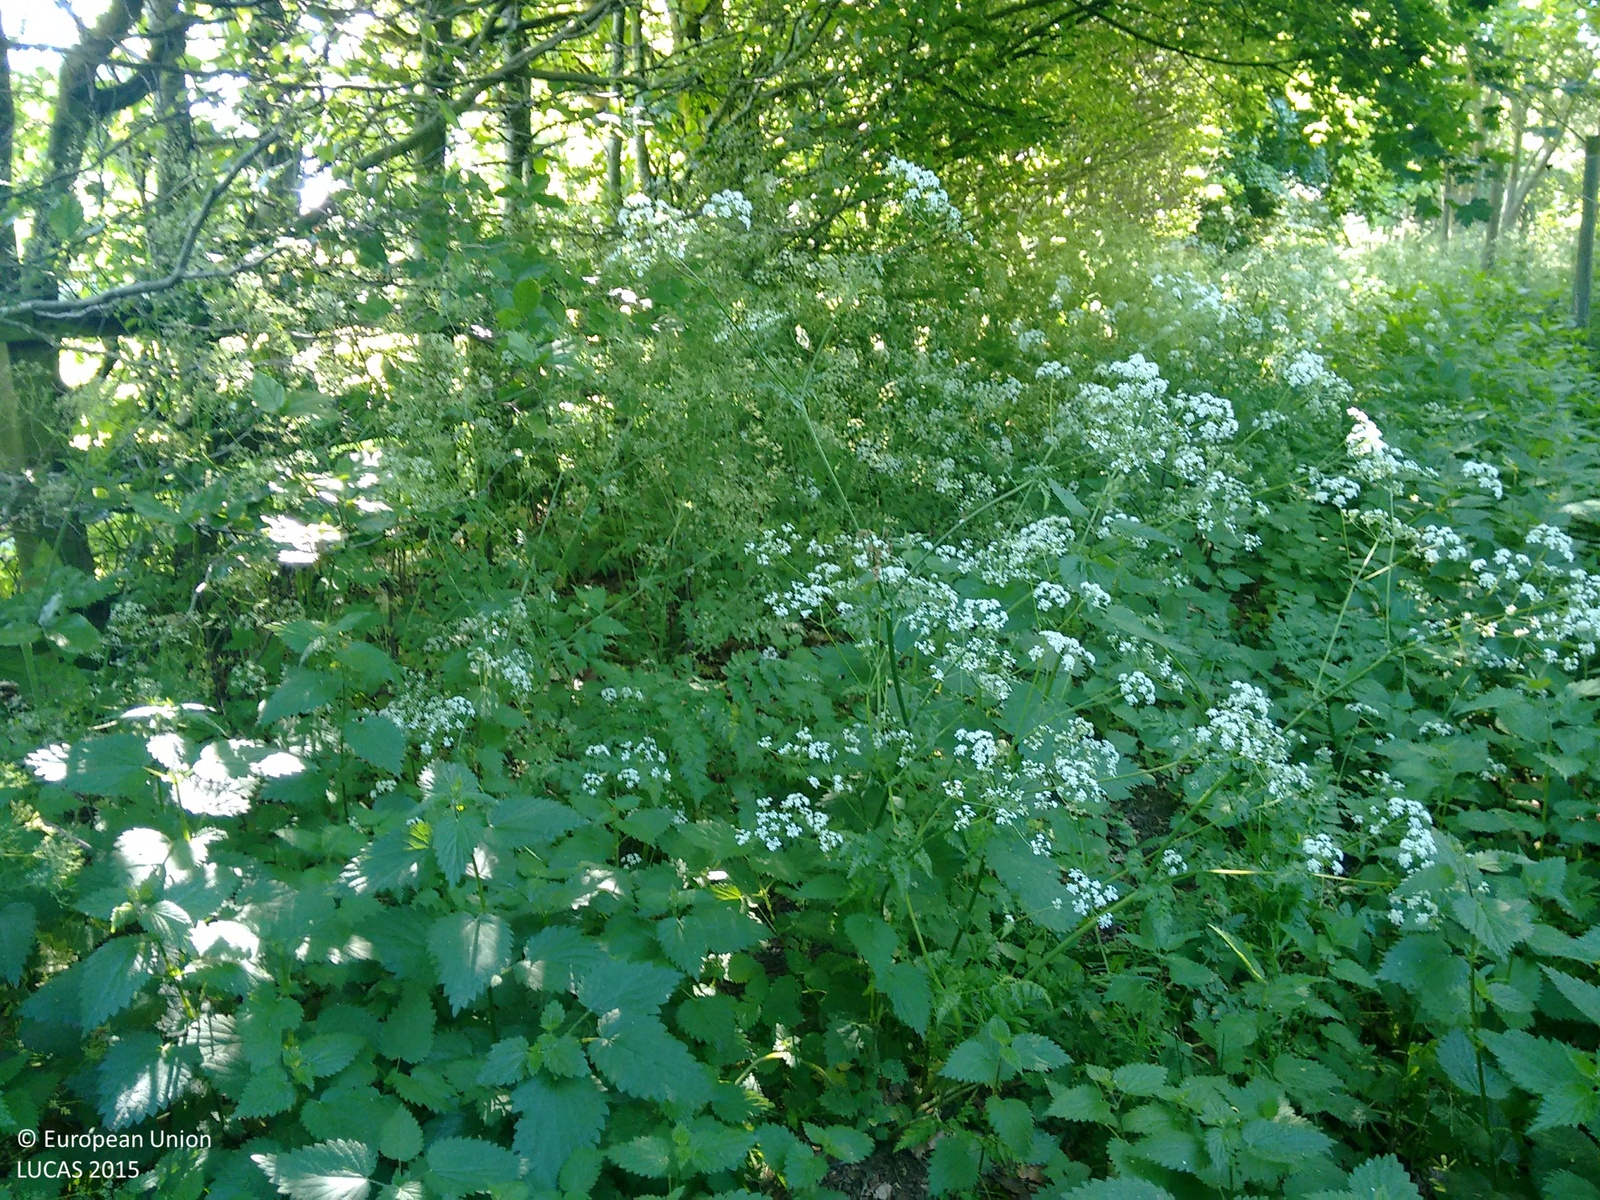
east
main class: Woodland
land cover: Broadleaved woodland
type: mesophytic deciduous forest
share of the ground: > 75 %
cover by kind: broadleaved forest trees 95 %, shrubs 5 %
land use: Forestry
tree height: > 5 m
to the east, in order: Broadleaved woodland; Fences; Spontaneously vegetated surfaces; Fences; Lines of trees; Grassland without tree/shrub cover; Fences; Grassland without tree/shrub cover; Fences; Grass margins; Managed hedges; Fences; Ditches and canals; Grass margins; Paved roads, cycling and walking lanes; Grass margins; Ditches and canals; Lines of trees; Grassland without tree/shrub cover; Common wheat
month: June
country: GB
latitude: 51.9676
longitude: -1.6244
